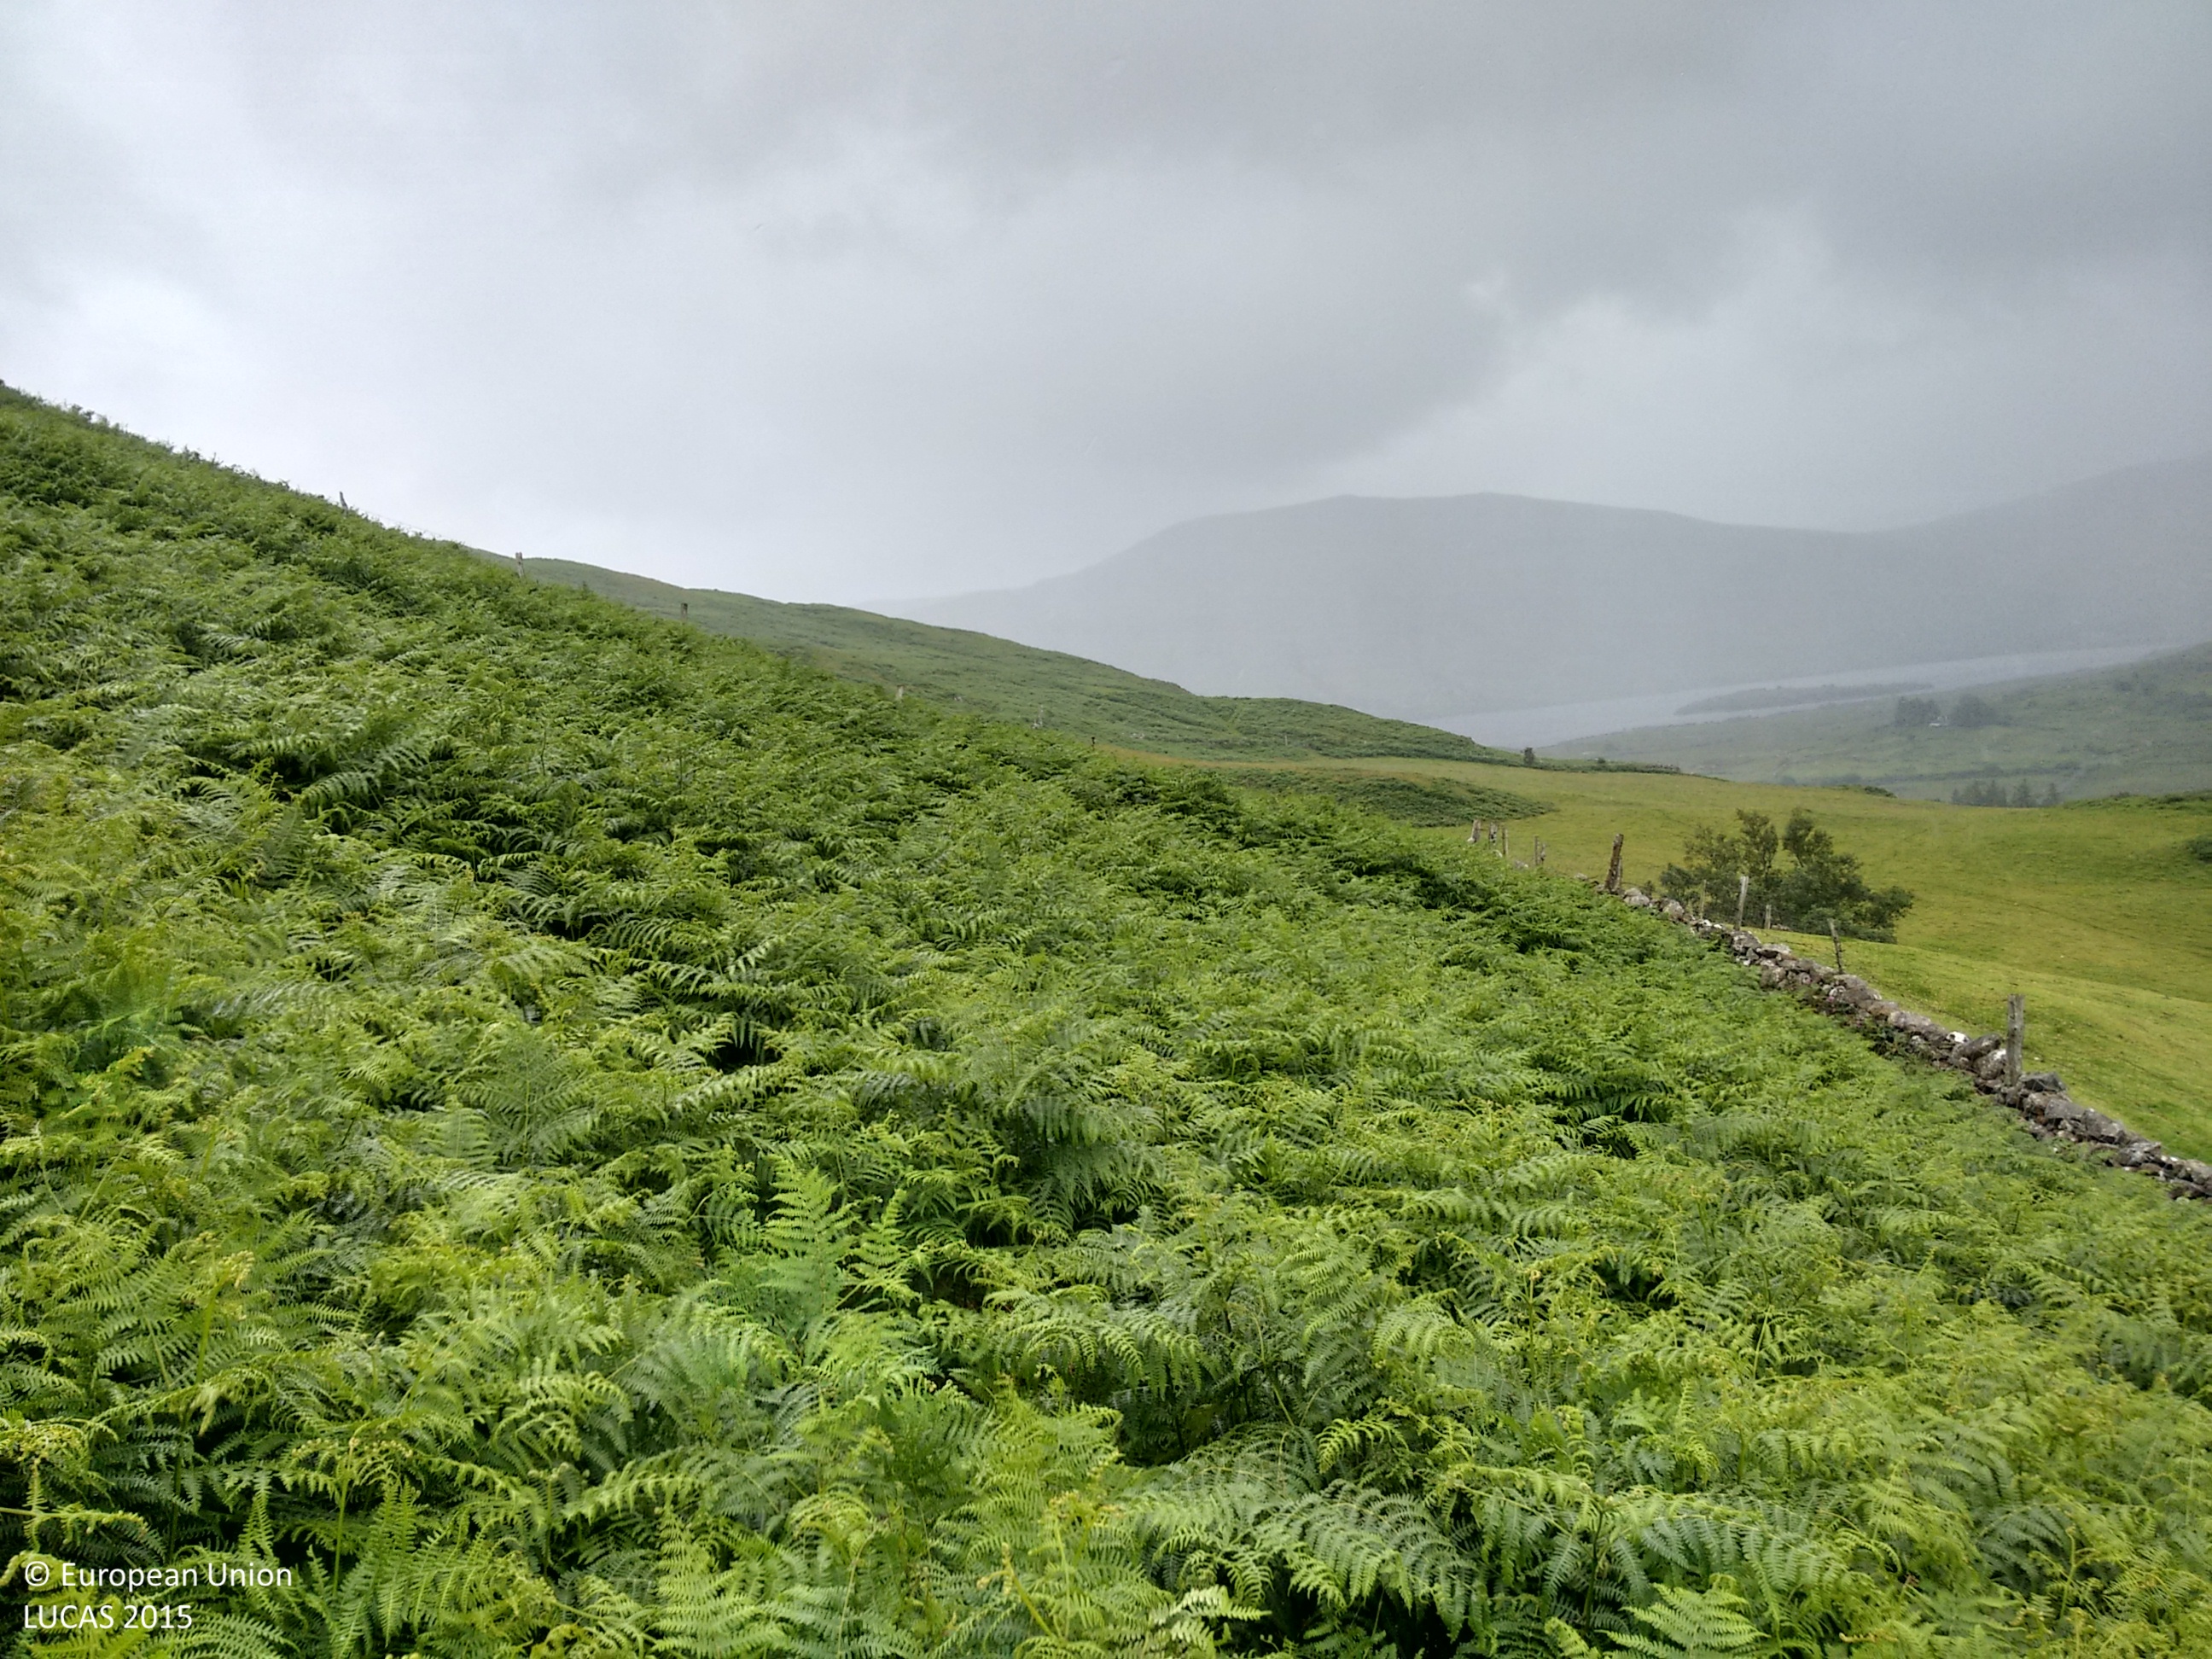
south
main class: Grassland
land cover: Spontaneously vegetated surfaces
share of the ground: > 75 %
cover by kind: herbaceous plants 100 %
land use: Semi-natural and natural areas not in use
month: July
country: IE
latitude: 53.5749
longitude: -9.4871
